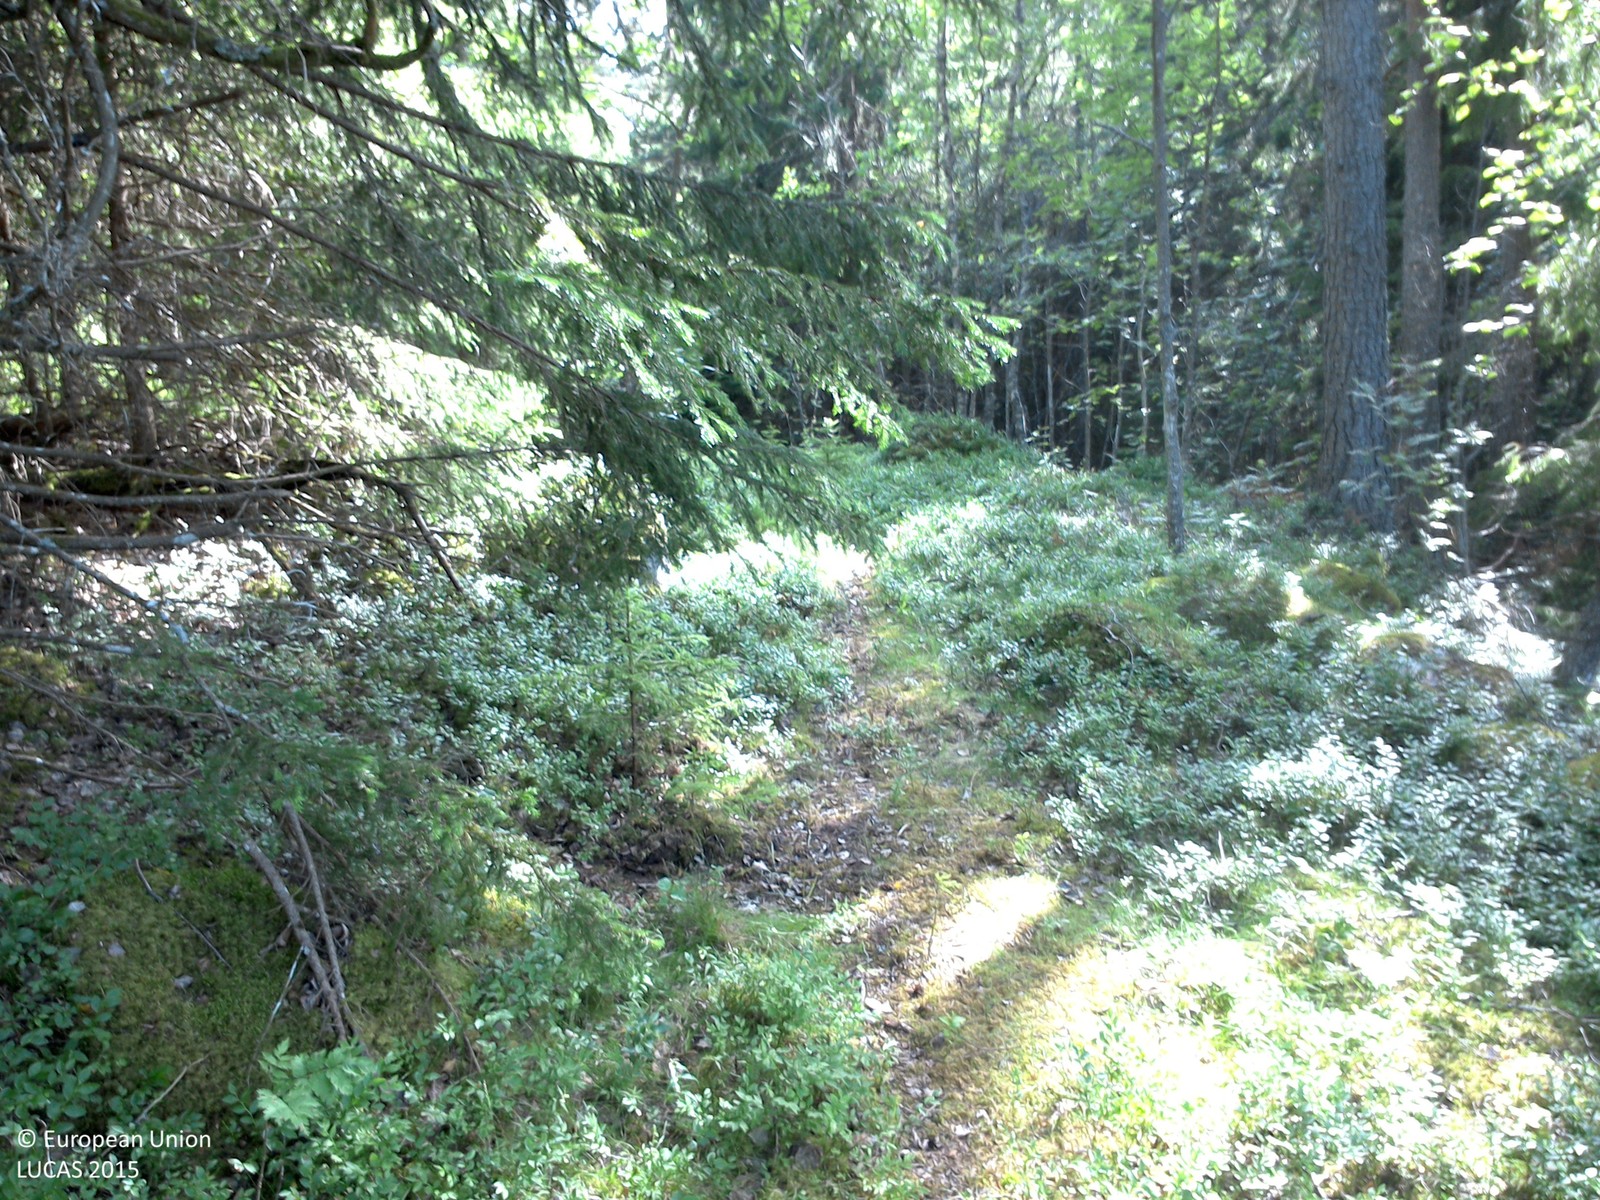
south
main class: Woodland
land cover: Spruce dominated mixed woodland
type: boreal forest
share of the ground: 50 - 75 %
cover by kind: coniferous forest trees 50 %, broadleaved forest trees 20 %, herbaceous plants 20 %, lichens and mosses 10 %
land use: Forestry
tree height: > 5 m
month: July
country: SE
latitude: 57.9638
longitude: 15.0150
